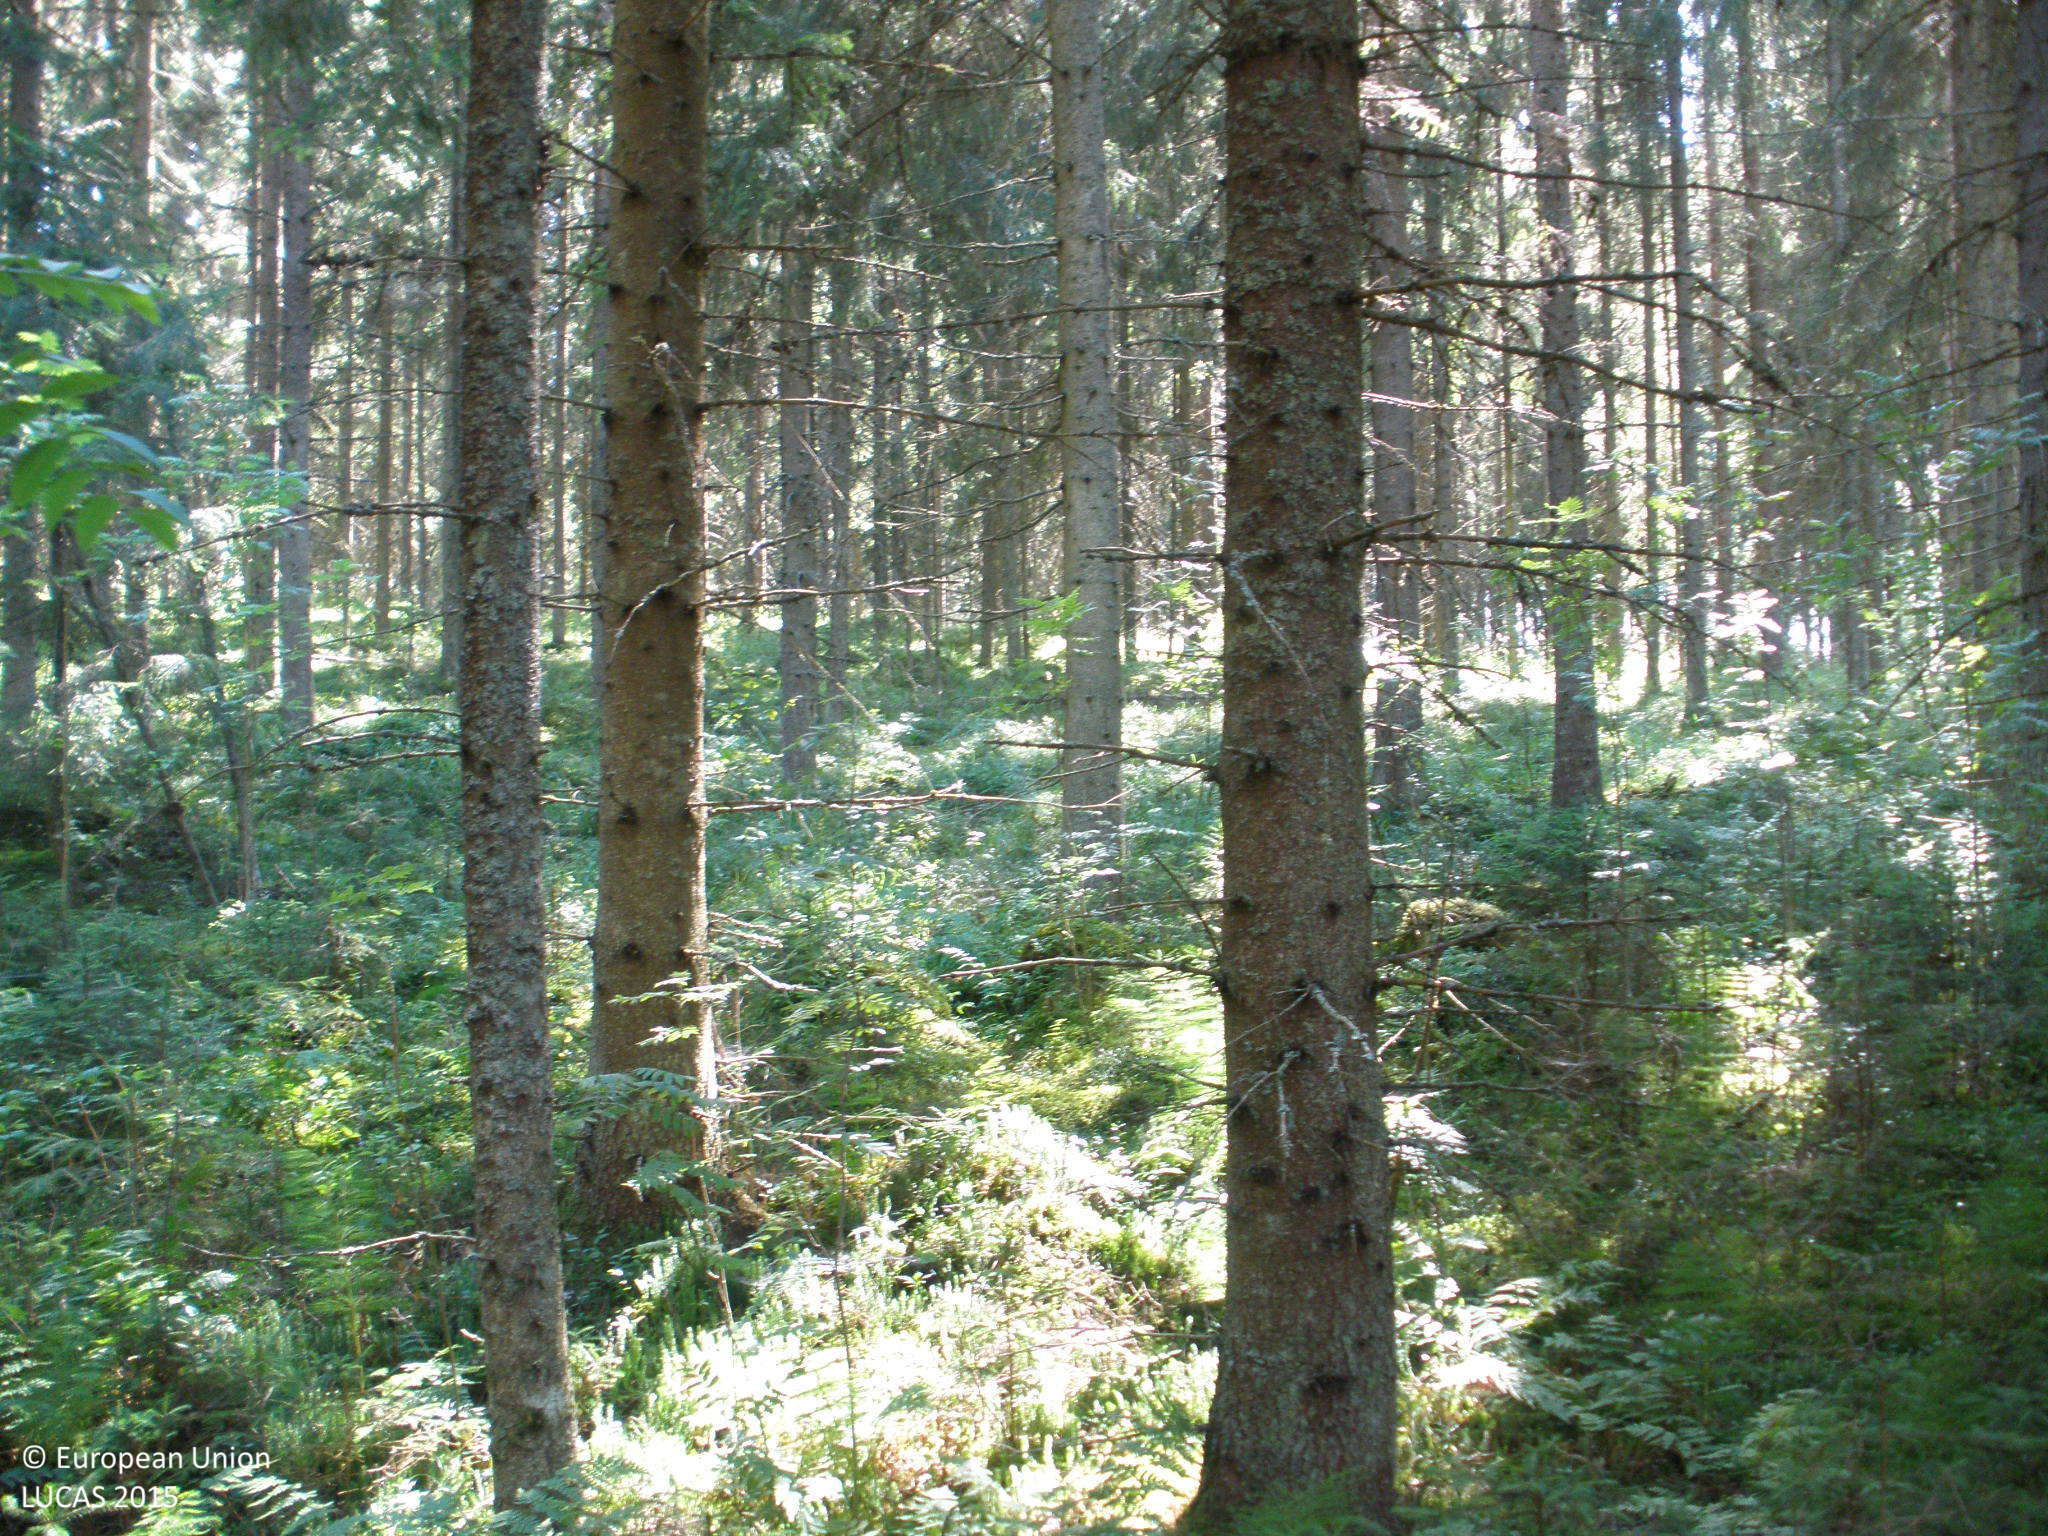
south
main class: Woodland
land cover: Spruce dominated coniferous woodland
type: boreal forest
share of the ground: > 75 %
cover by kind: coniferous forest trees 90 %, herbaceous plants 5 %, lichens and mosses 5 %
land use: Forestry
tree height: > 5 m
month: August
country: FI
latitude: 60.8177
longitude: 24.3497
